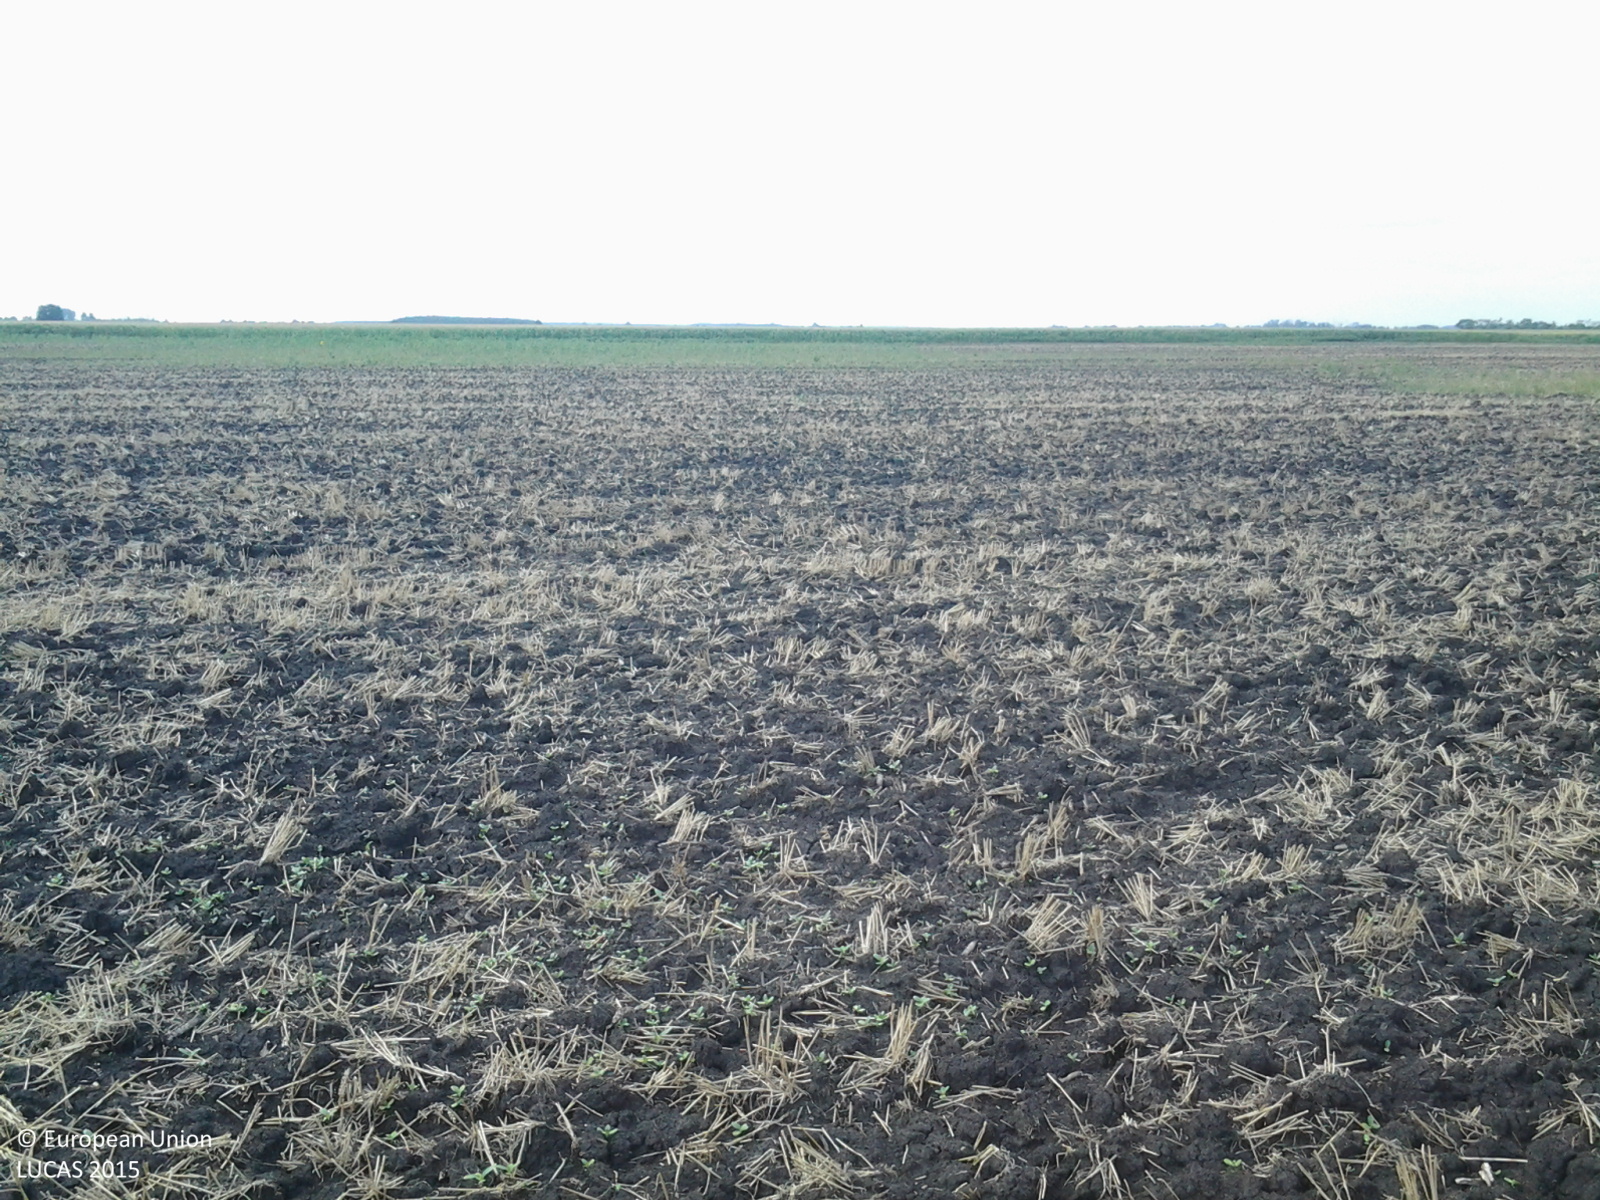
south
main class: Cropland
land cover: Common wheat
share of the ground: < 10 %
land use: Agriculture (excluding fallow land and kitchen gardens)
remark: Harvested field
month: July
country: HU
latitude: 47.1361
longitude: 21.2581
